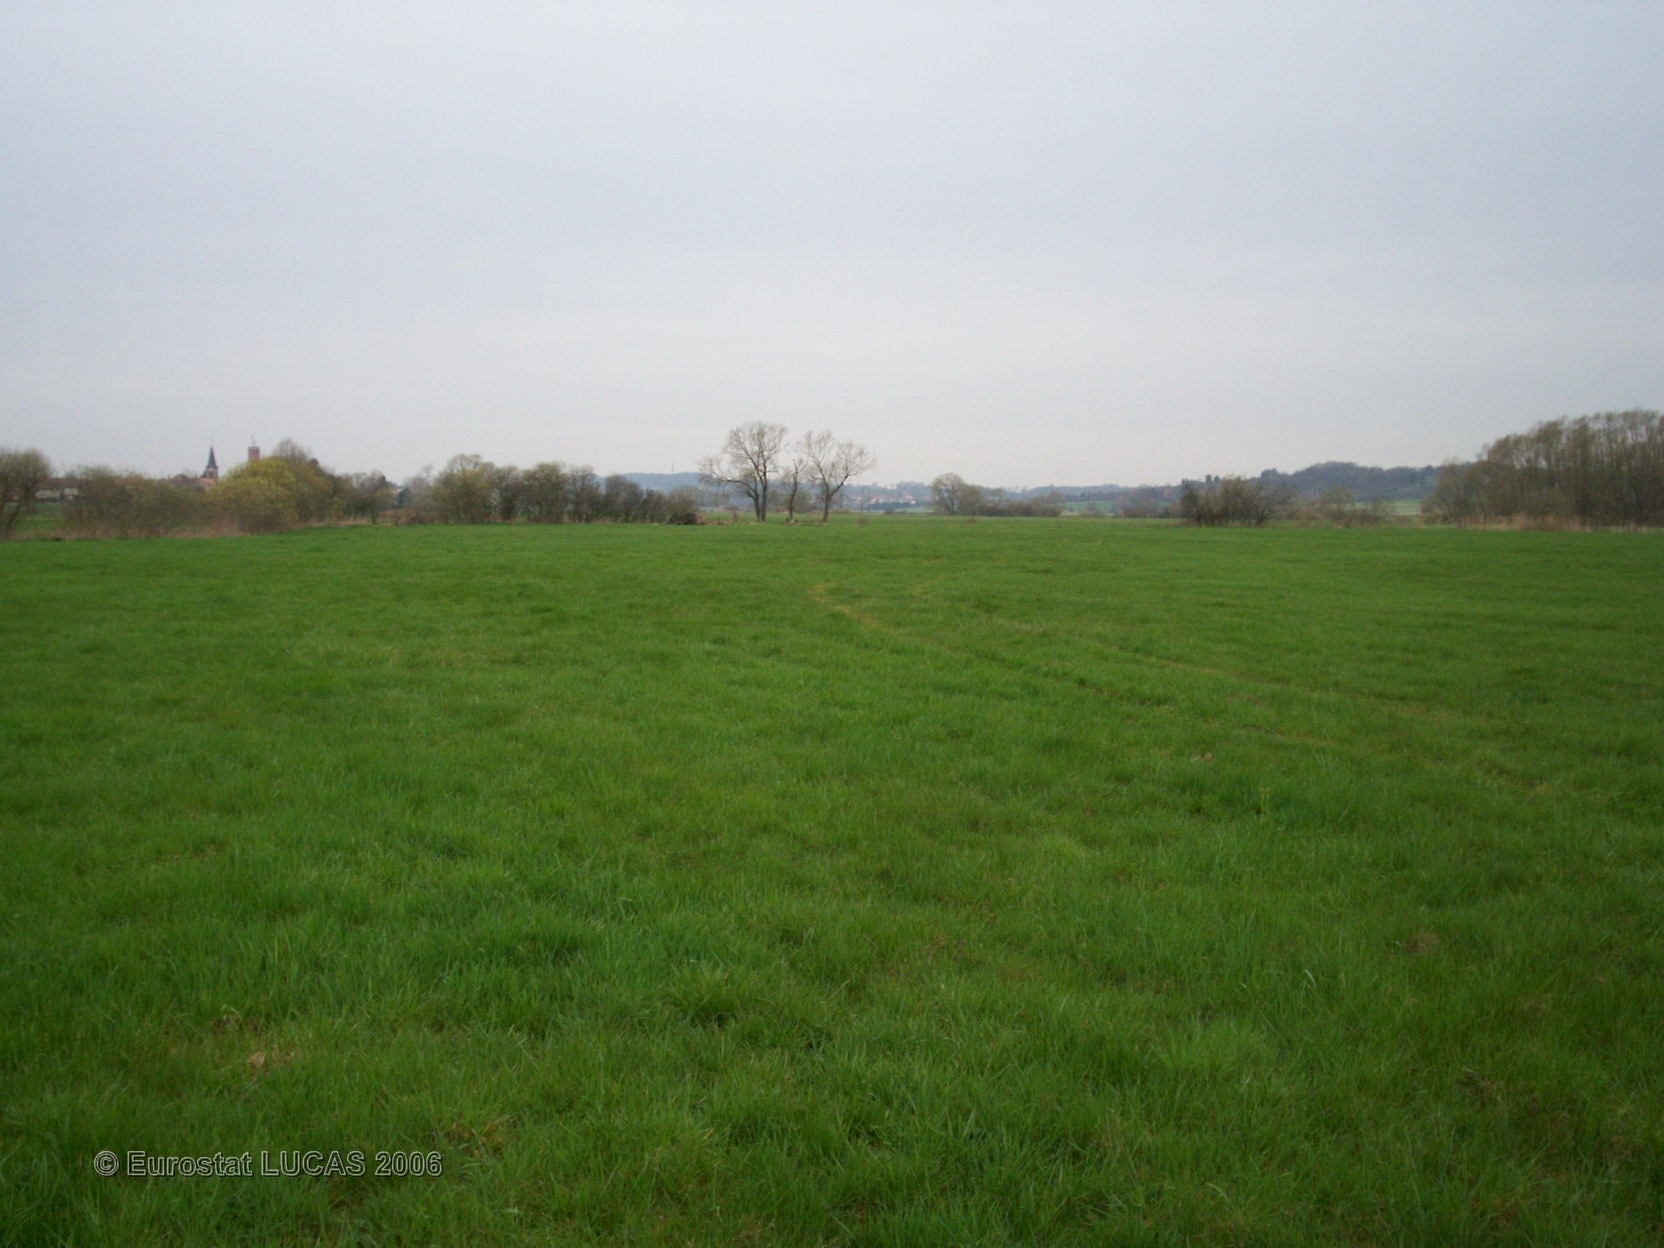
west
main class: Grassland
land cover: Grassland without tree/shrub cover
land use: Agriculture (excluding fallow land and kitchen gardens)
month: April
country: FR
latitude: 48.6016
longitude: 6.5424
